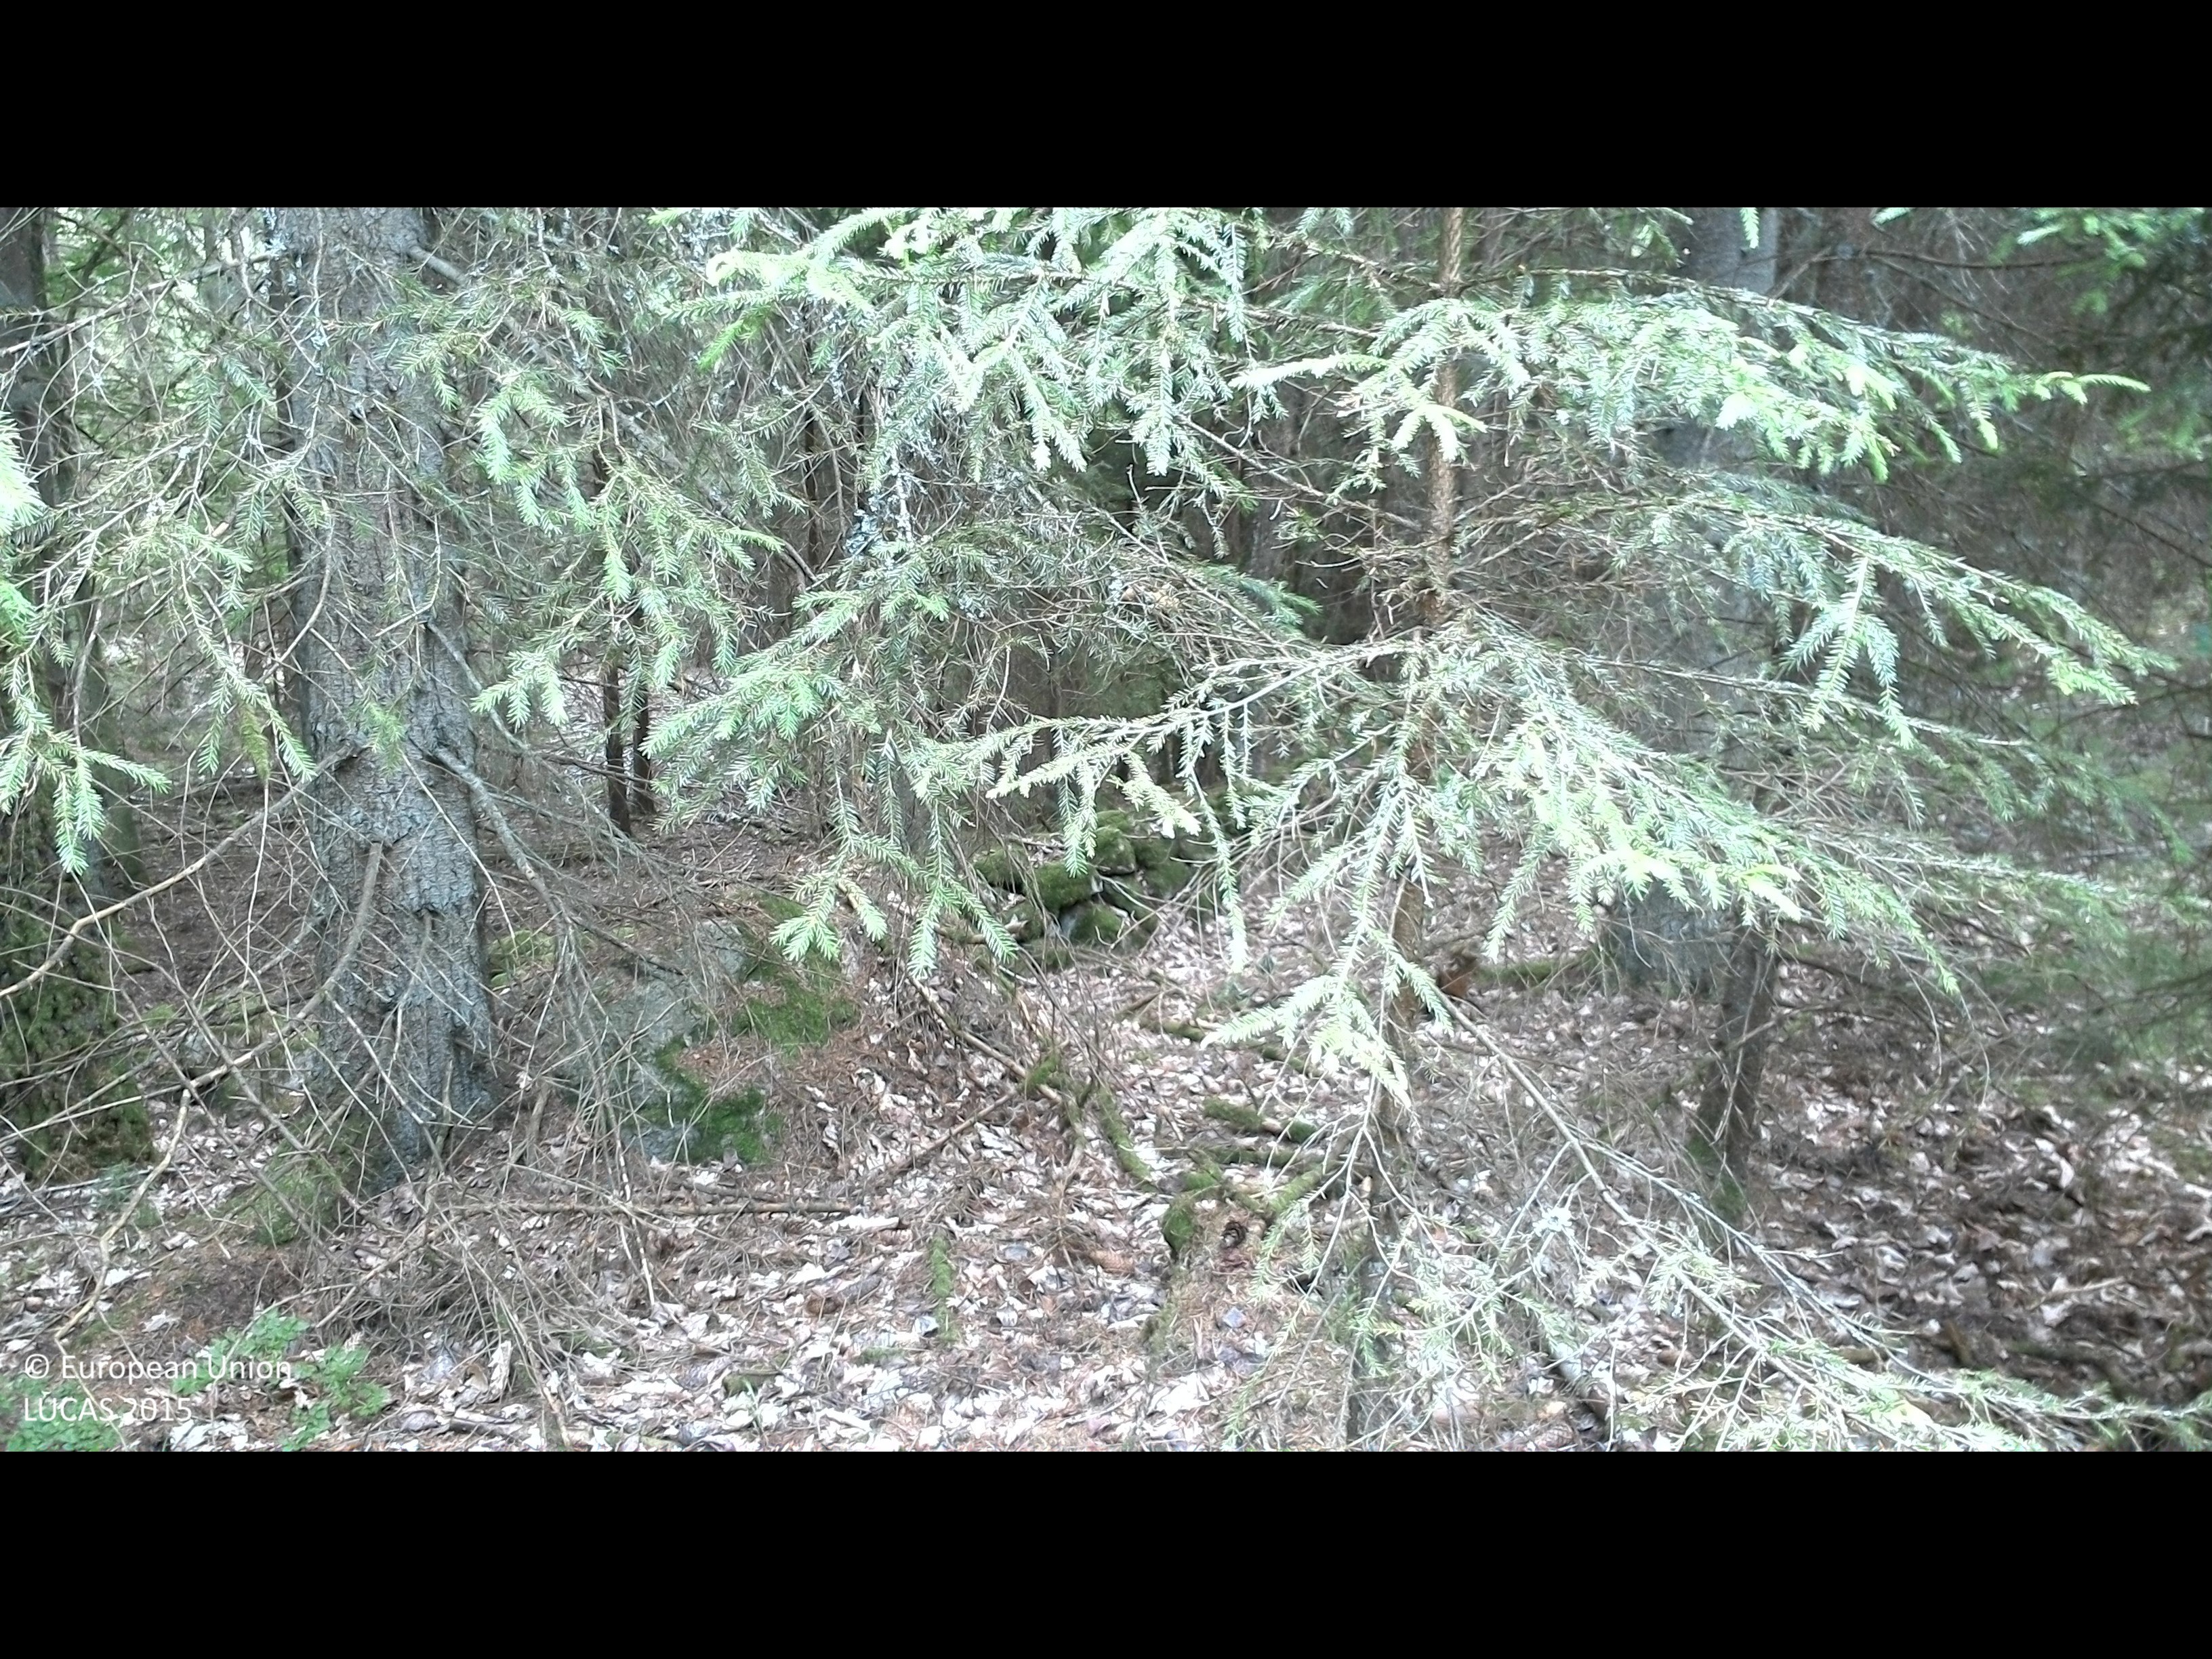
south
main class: Woodland
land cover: Spruce dominated coniferous woodland
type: boreal forest
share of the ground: 50 - 75 %
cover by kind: coniferous forest trees 50 %, shrubs 20 %, herbaceous plants 15 %, lichens and mosses 10 %, broadleaved forest trees 5 %
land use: Forestry
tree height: > 5 m
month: July
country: SE
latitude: 56.3311
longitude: 15.2876
